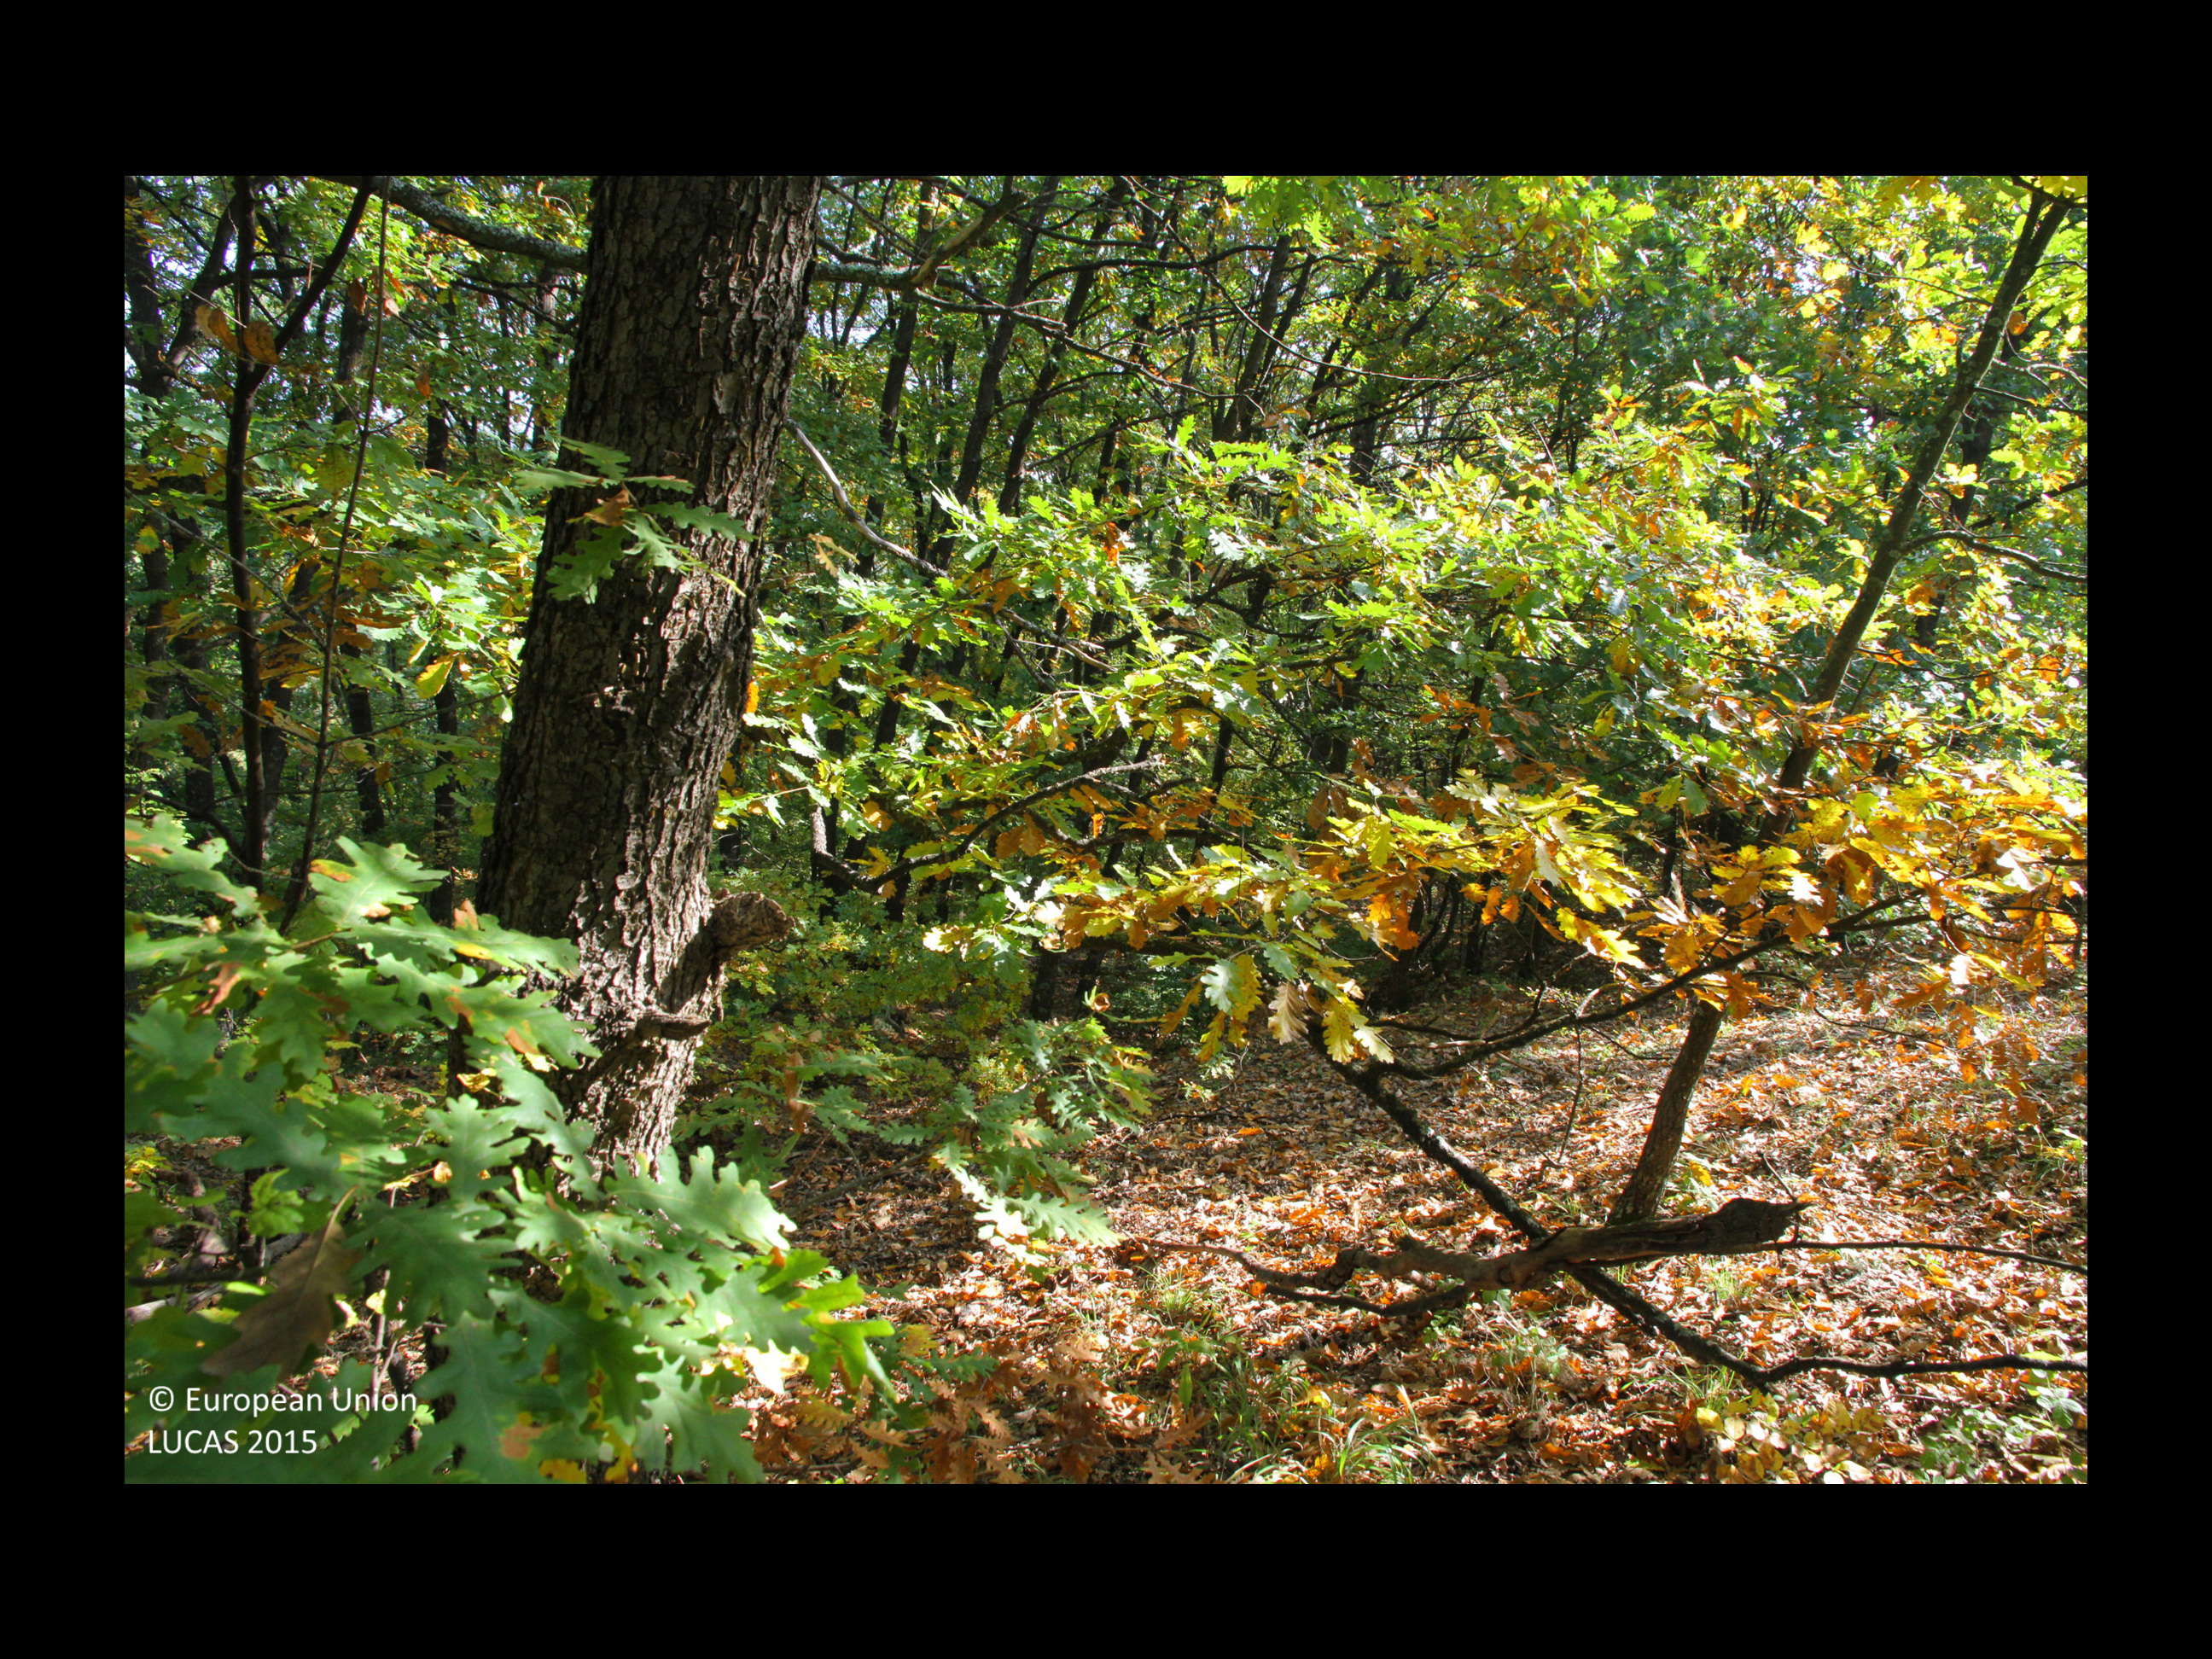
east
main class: Woodland
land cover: Broadleaved woodland
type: mesophytic deciduous forest
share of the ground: > 75 %
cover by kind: broadleaved forest trees 100 %
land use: Forestry
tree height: > 5 m
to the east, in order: Broadleaved woodland; Rivers and streams; Broadleaved woodland; Rivers and streams; Broadleaved woodland; Rivers and streams; Broadleaved woodland
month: October
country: BG
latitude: 42.9986
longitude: 26.9517
